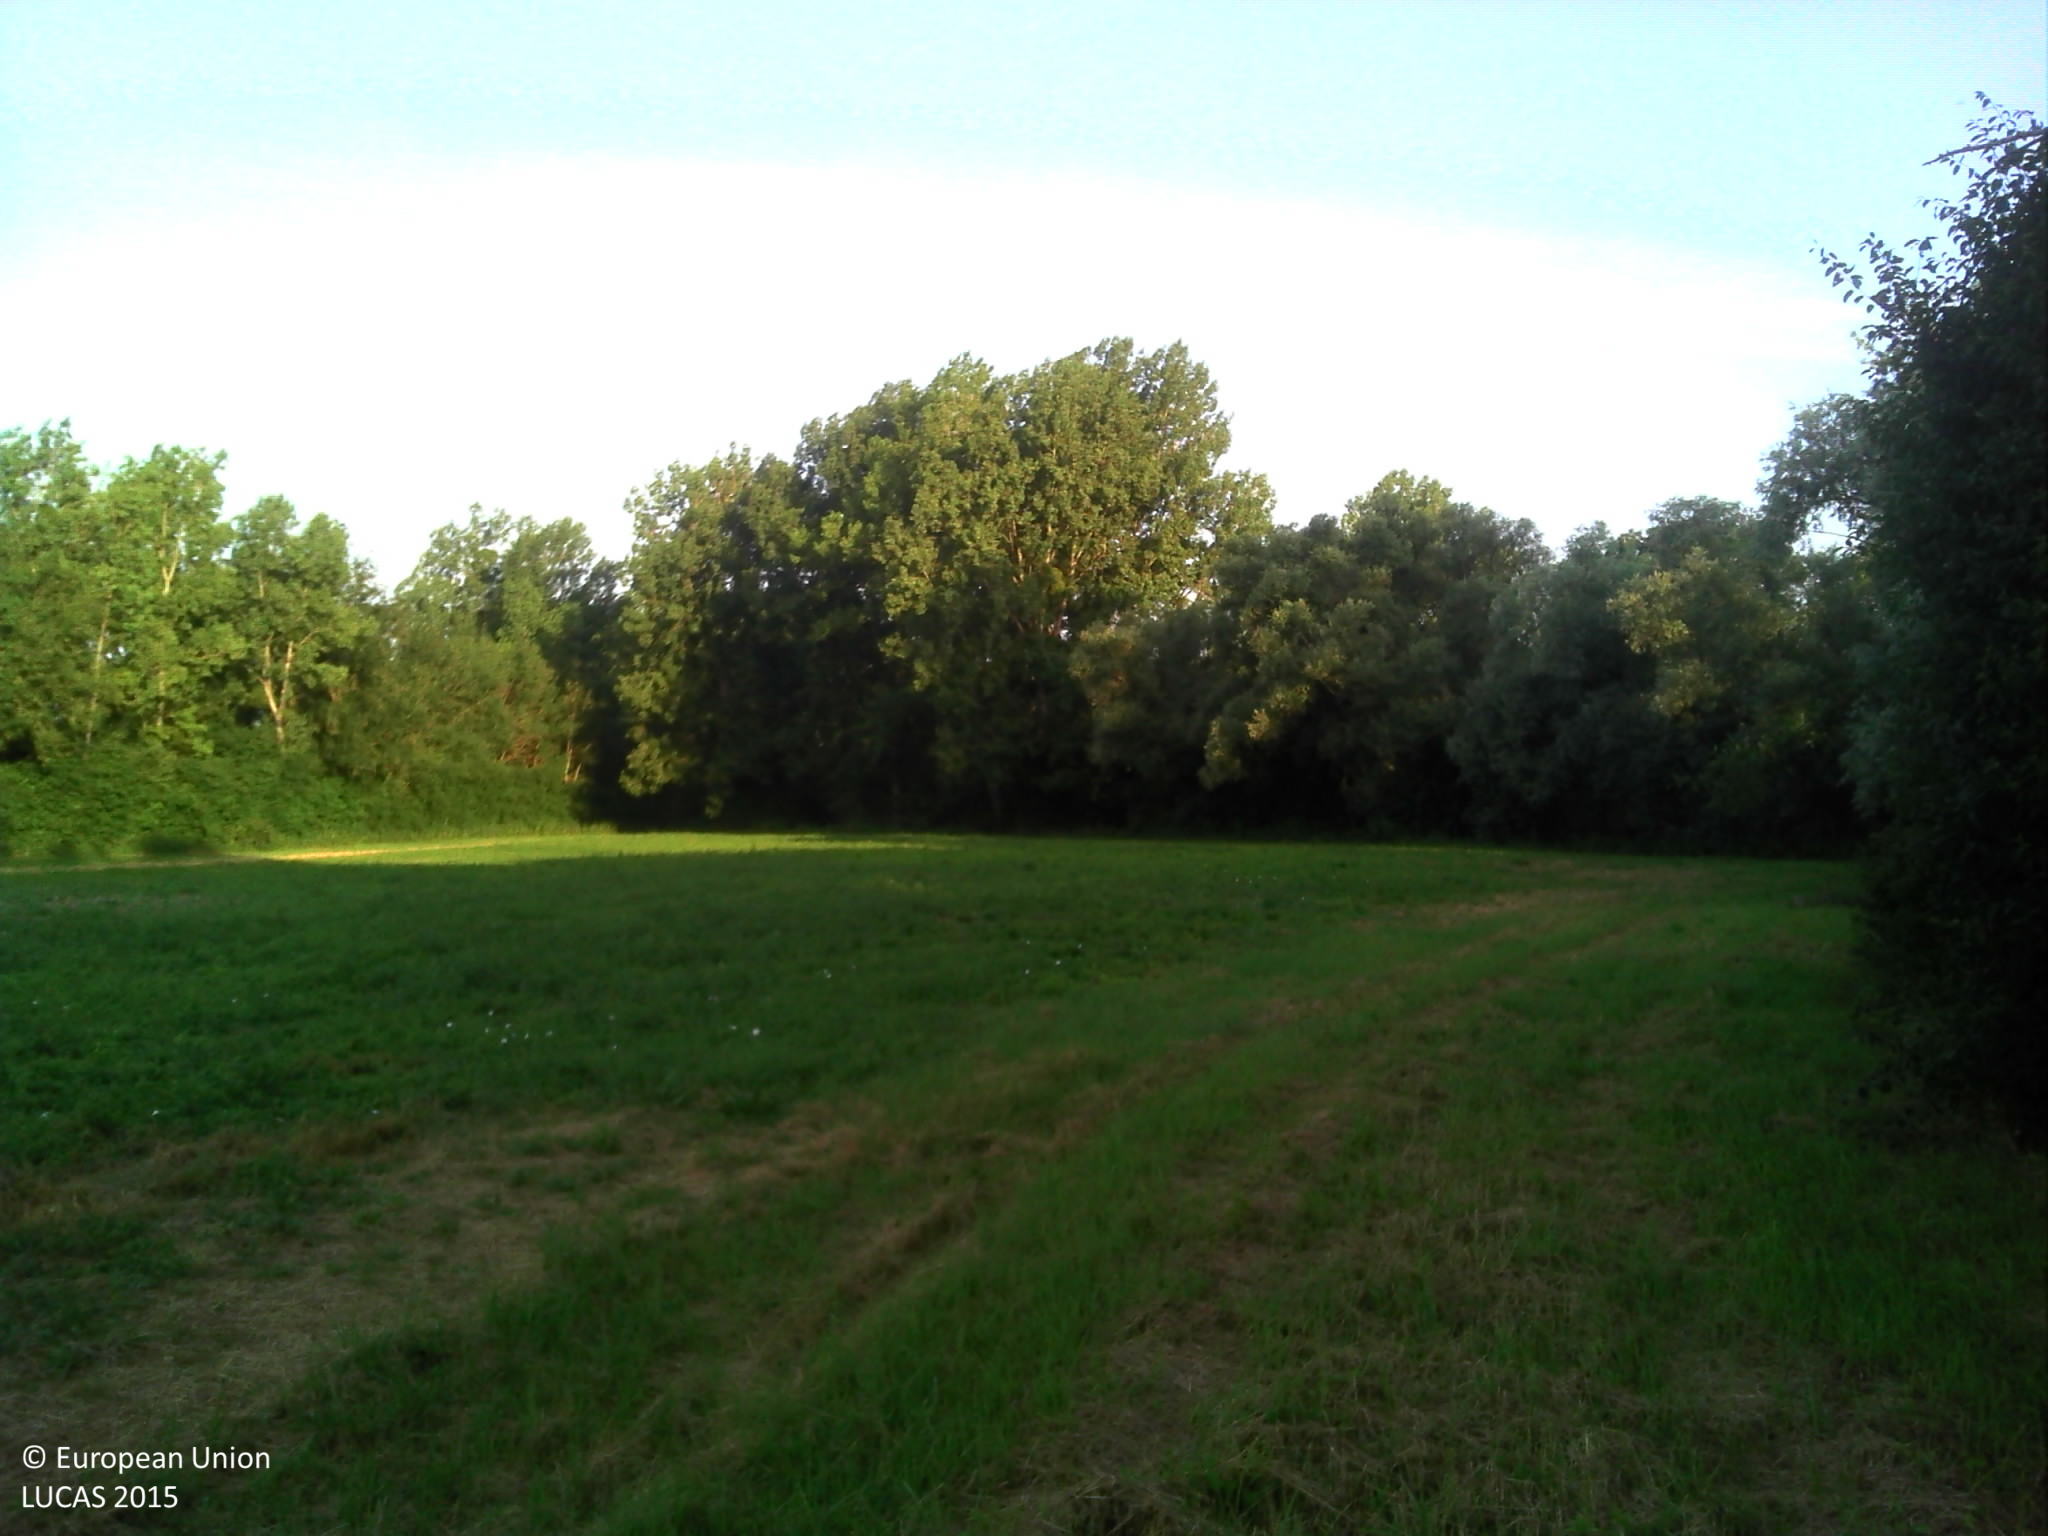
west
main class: Grassland
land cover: Grassland without tree/shrub cover
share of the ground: > 75 %
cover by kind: herbaceous plants 100 %
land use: Agriculture (excluding fallow land and kitchen gardens)
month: July
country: FR
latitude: 46.9305
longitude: 5.2338
